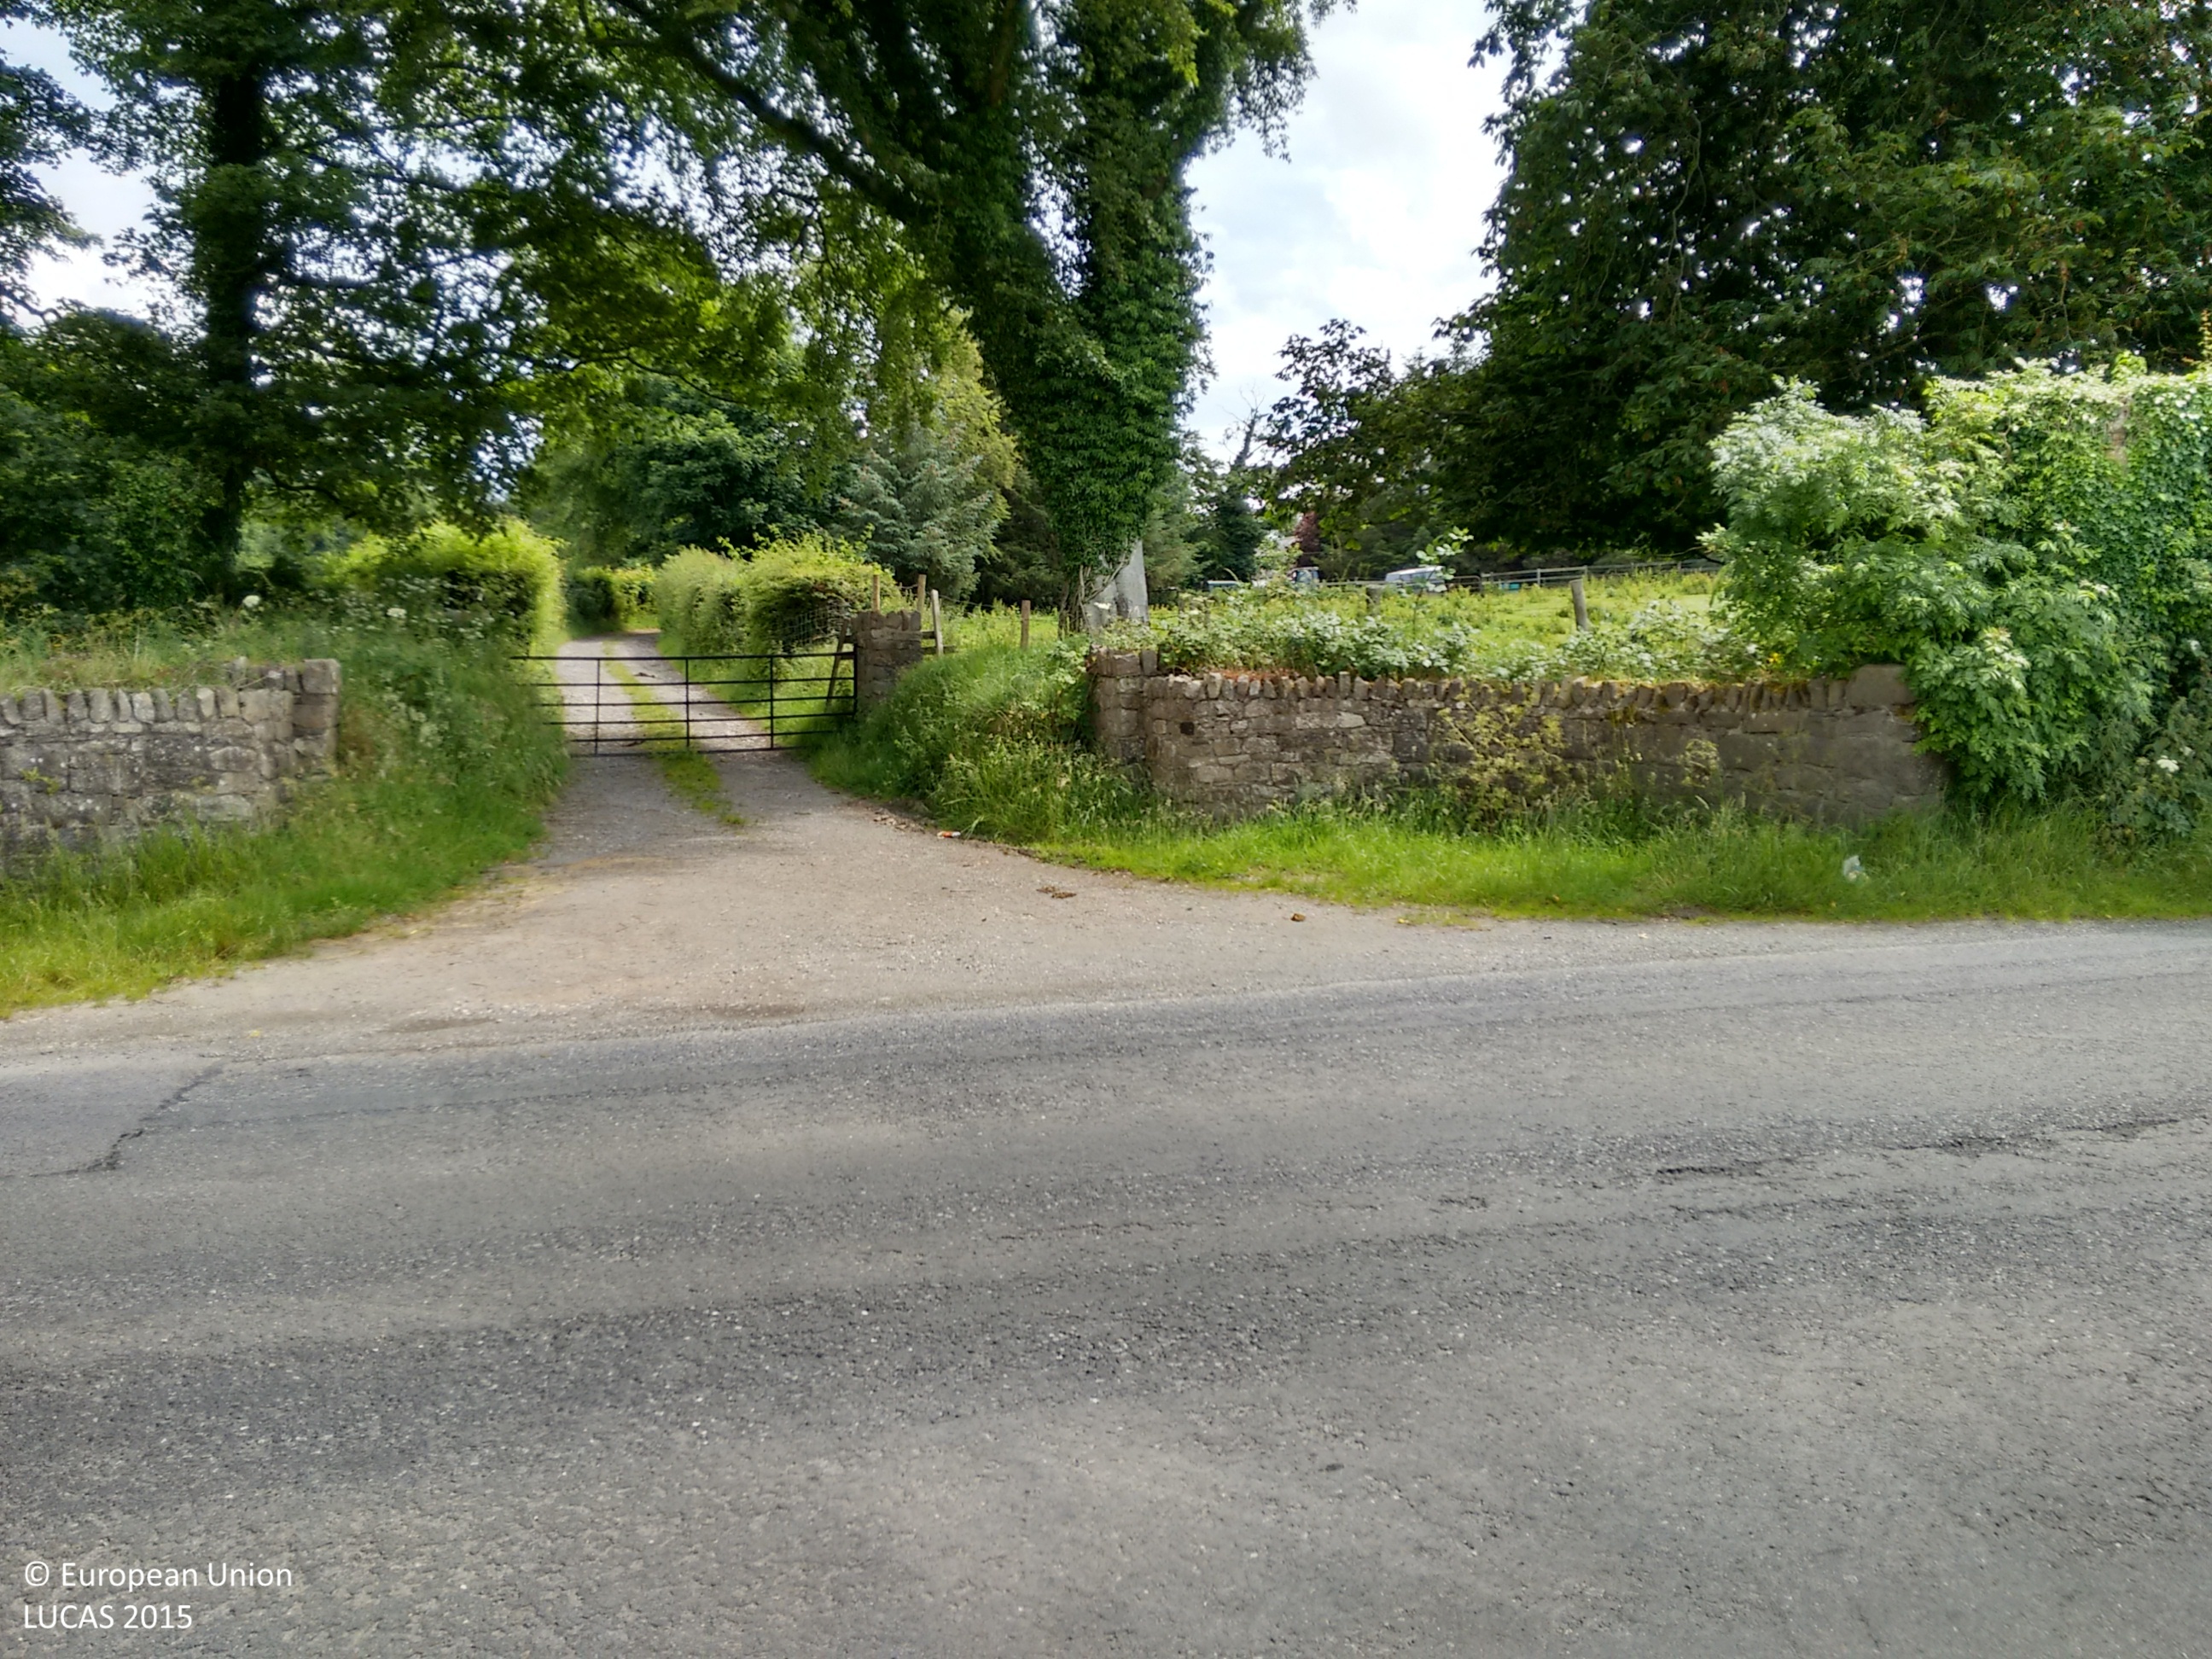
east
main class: Grassland
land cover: Grassland without tree/shrub cover
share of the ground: > 75 %
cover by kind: herbaceous plants 100 %
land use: Agriculture (excluding fallow land and kitchen gardens)
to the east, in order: Grassland without tree/shrub cover; Tracks; Grassland without tree/shrub cover; Fences; Managed hedges; Paved roads, cycling and walking lanes; Fences; Grassland with sparse tree/shrub cover; Tracks; Grassland without tree/shrub cover; Broadleaved woodland; Grass margins; Tracks
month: July
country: IE
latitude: 53.8555
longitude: -6.7817
